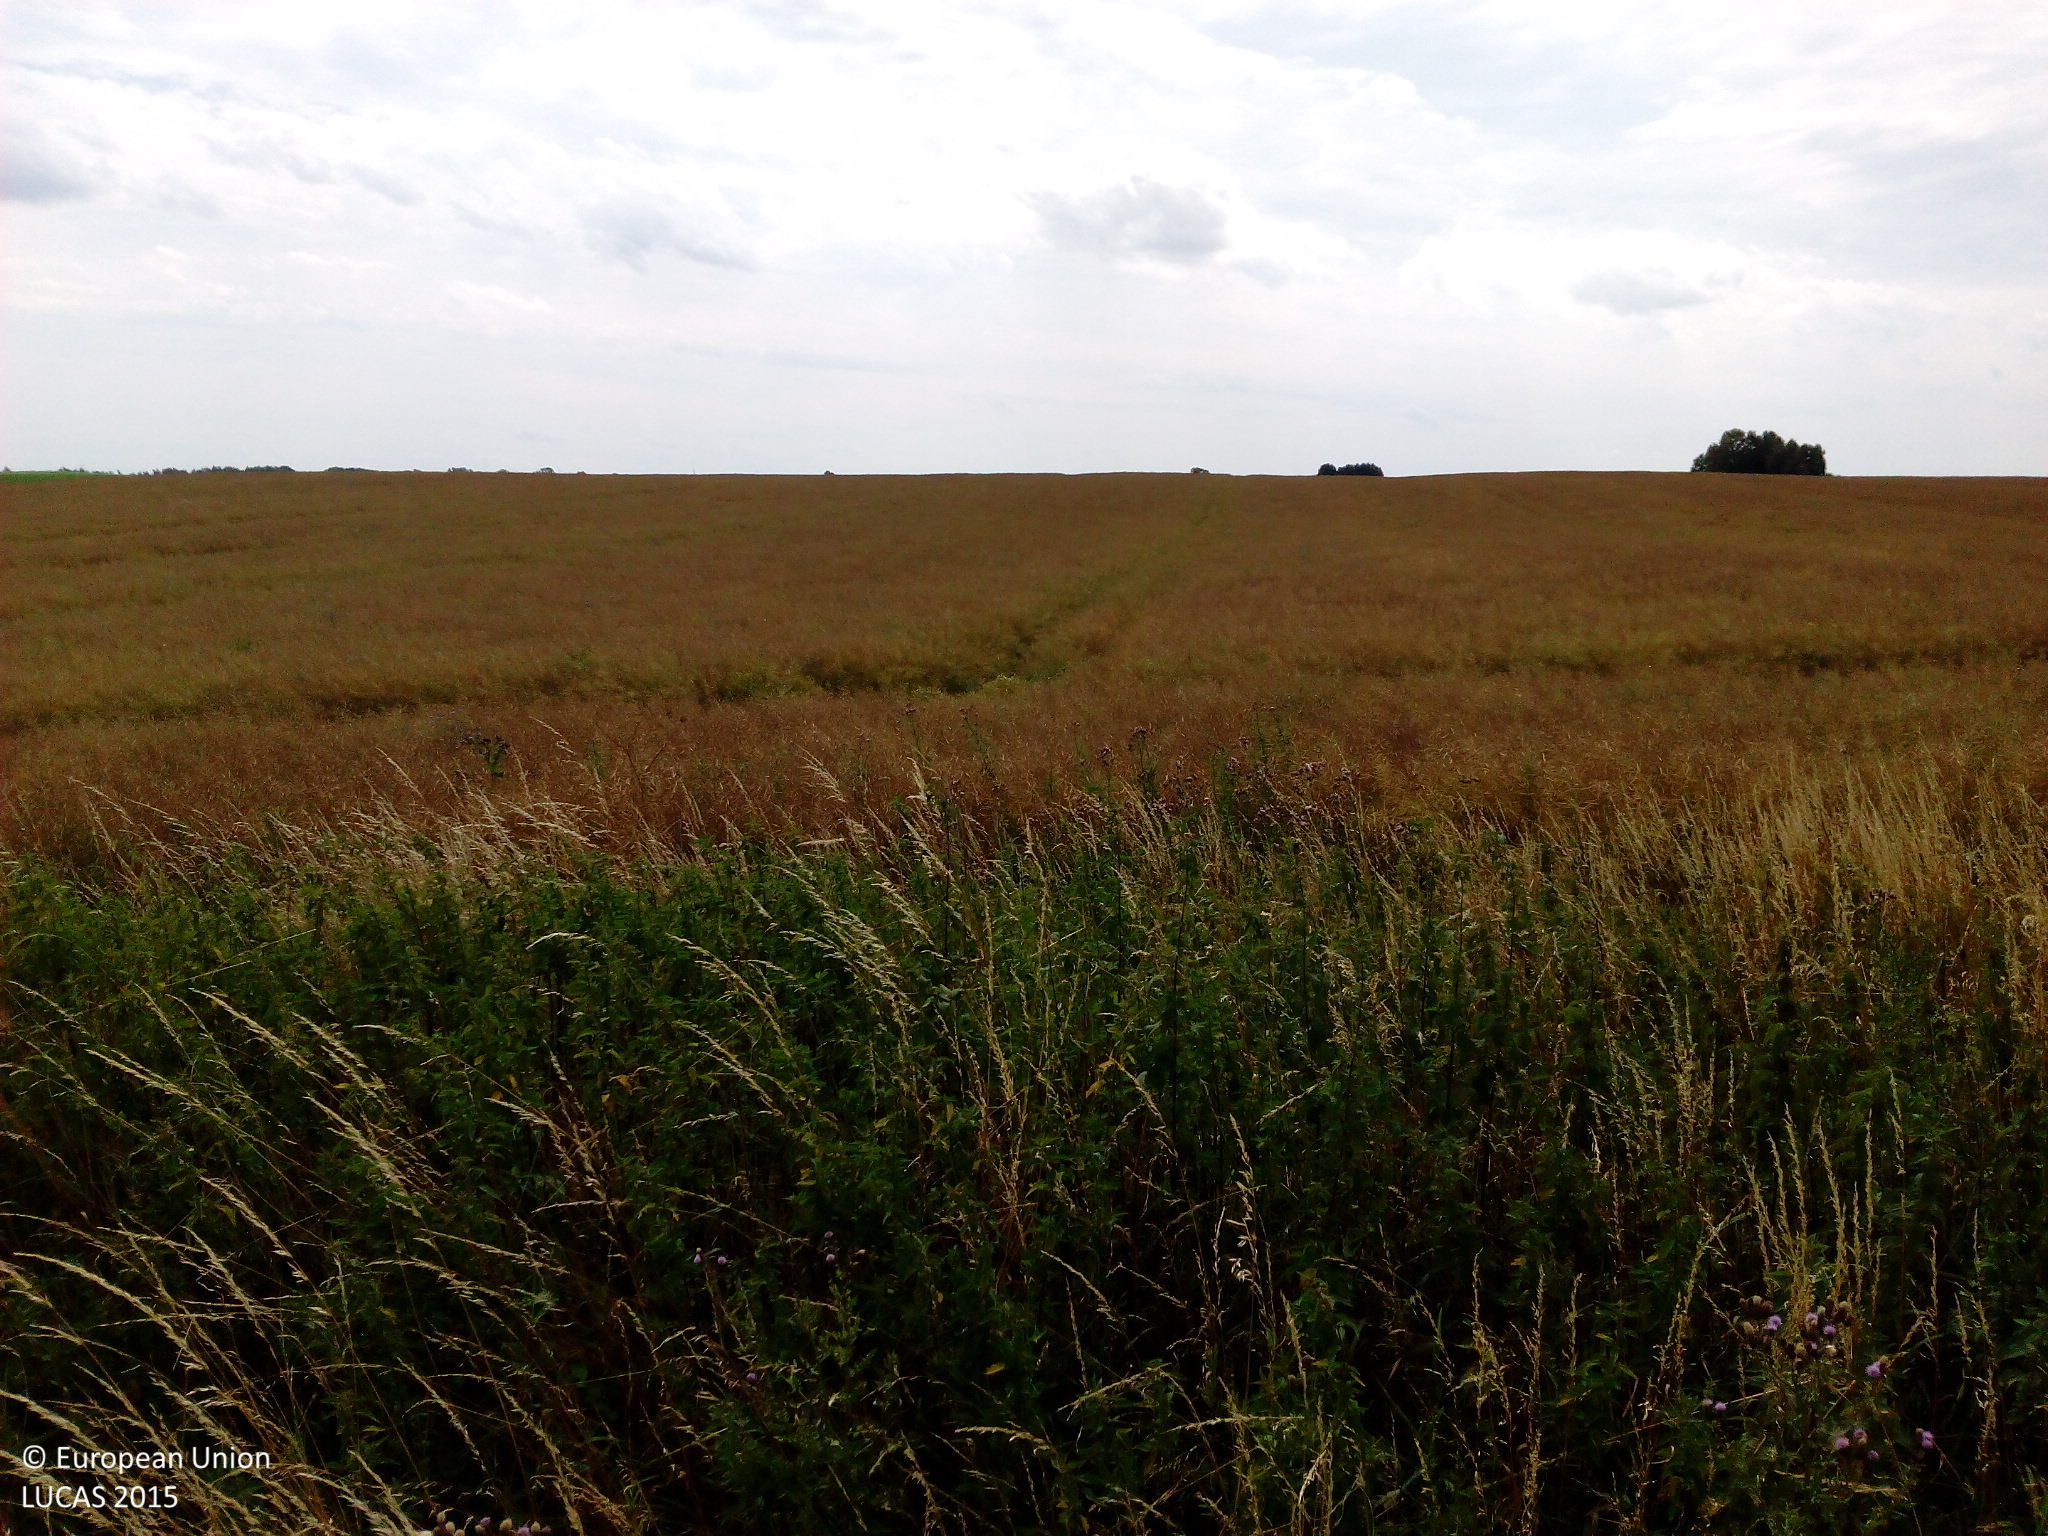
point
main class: Cropland
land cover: Rape and turnip rape
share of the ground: > 75 %
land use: Agriculture (excluding fallow land and kitchen gardens)
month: July
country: DE
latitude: 53.4358
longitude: 13.6879
